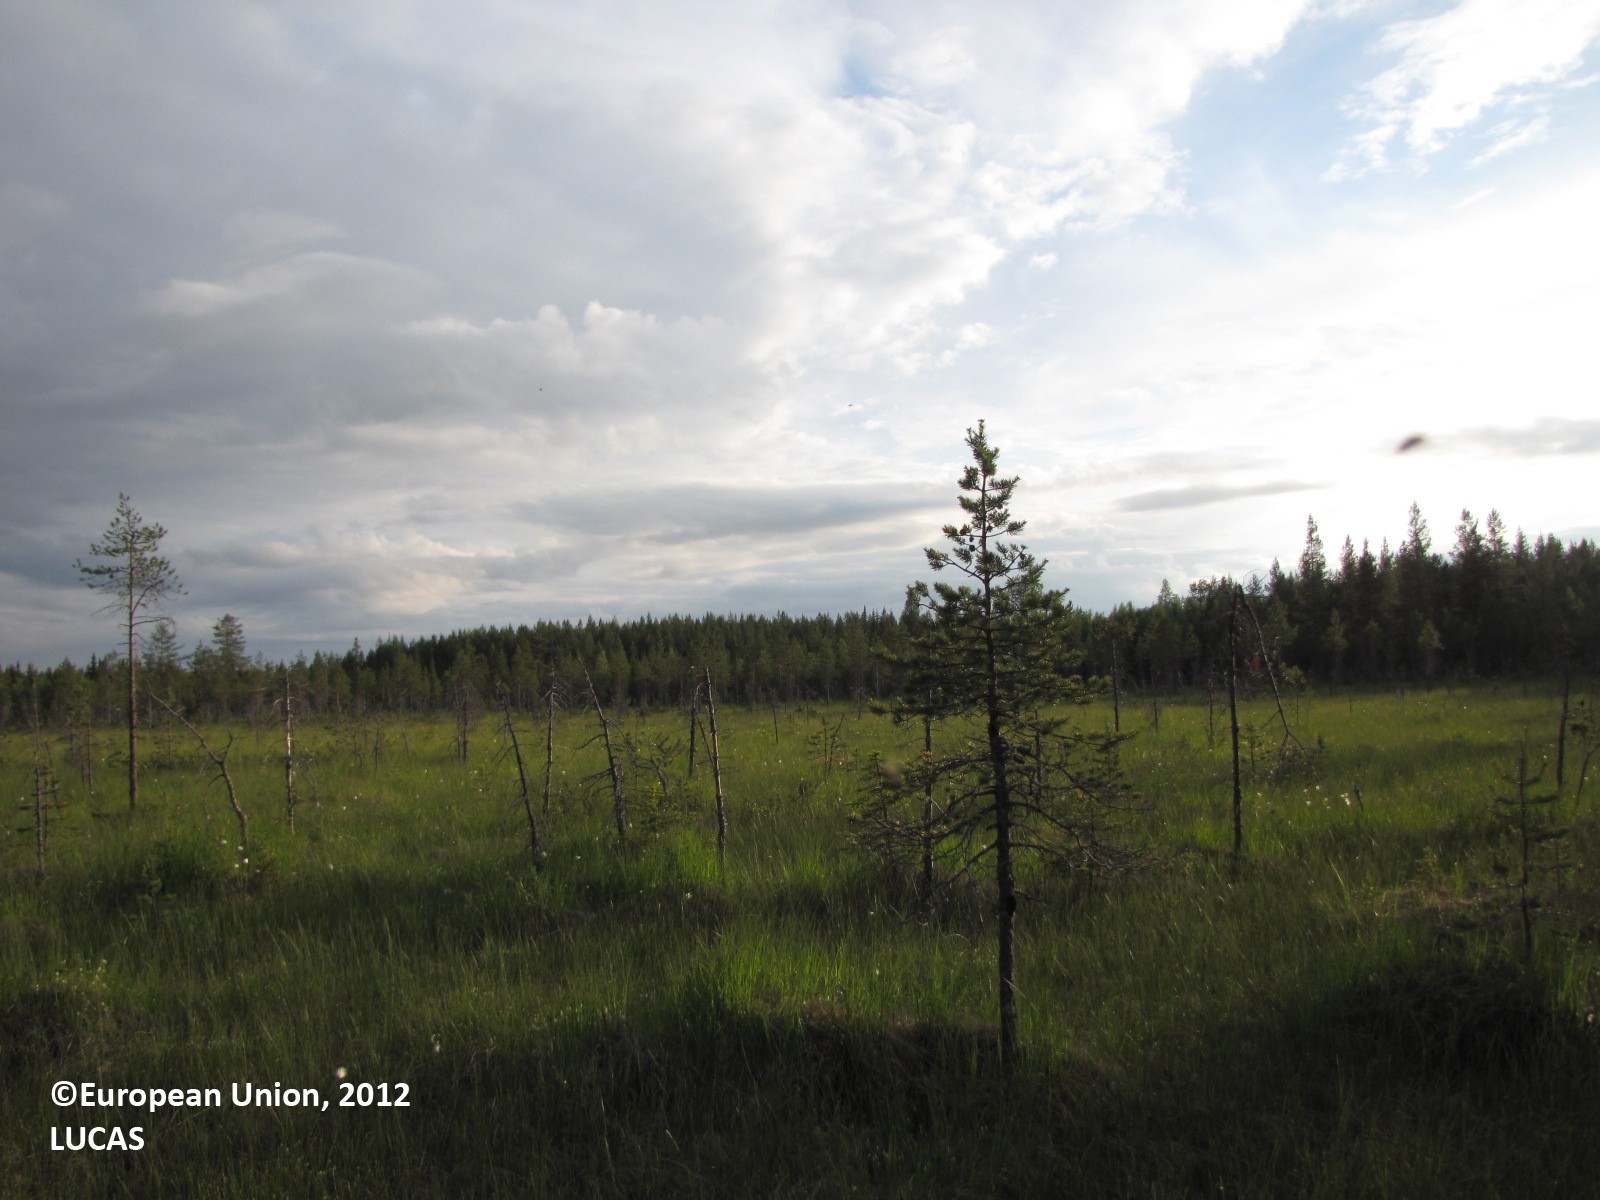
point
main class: Woodland
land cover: Pine dominated coniferous woodland
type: boreal forest
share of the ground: 10 - 25 %
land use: Forestry
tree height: > 5 m
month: July
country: FI
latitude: 66.3978
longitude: 24.9839
